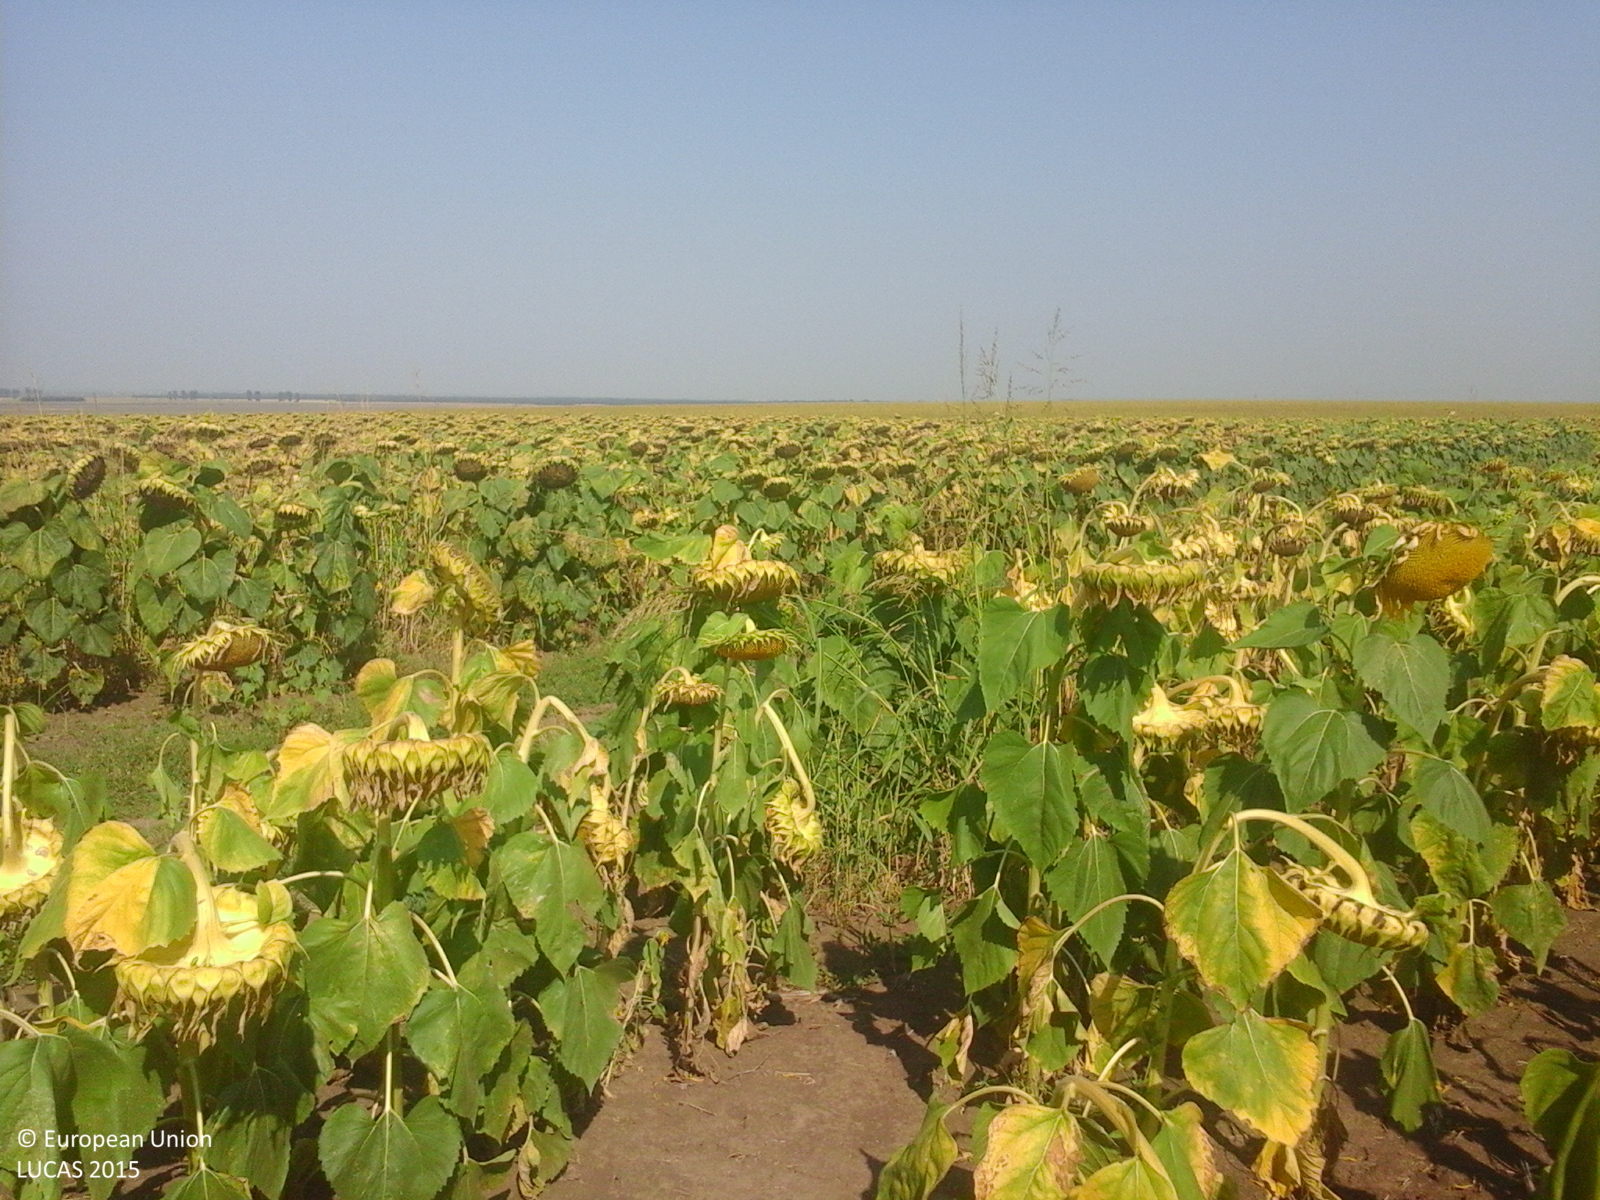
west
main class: Cropland
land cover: Sunflower
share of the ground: > 75 %
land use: Agriculture (excluding fallow land and kitchen gardens)
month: August
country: RO
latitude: 45.7251
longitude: 27.5946
